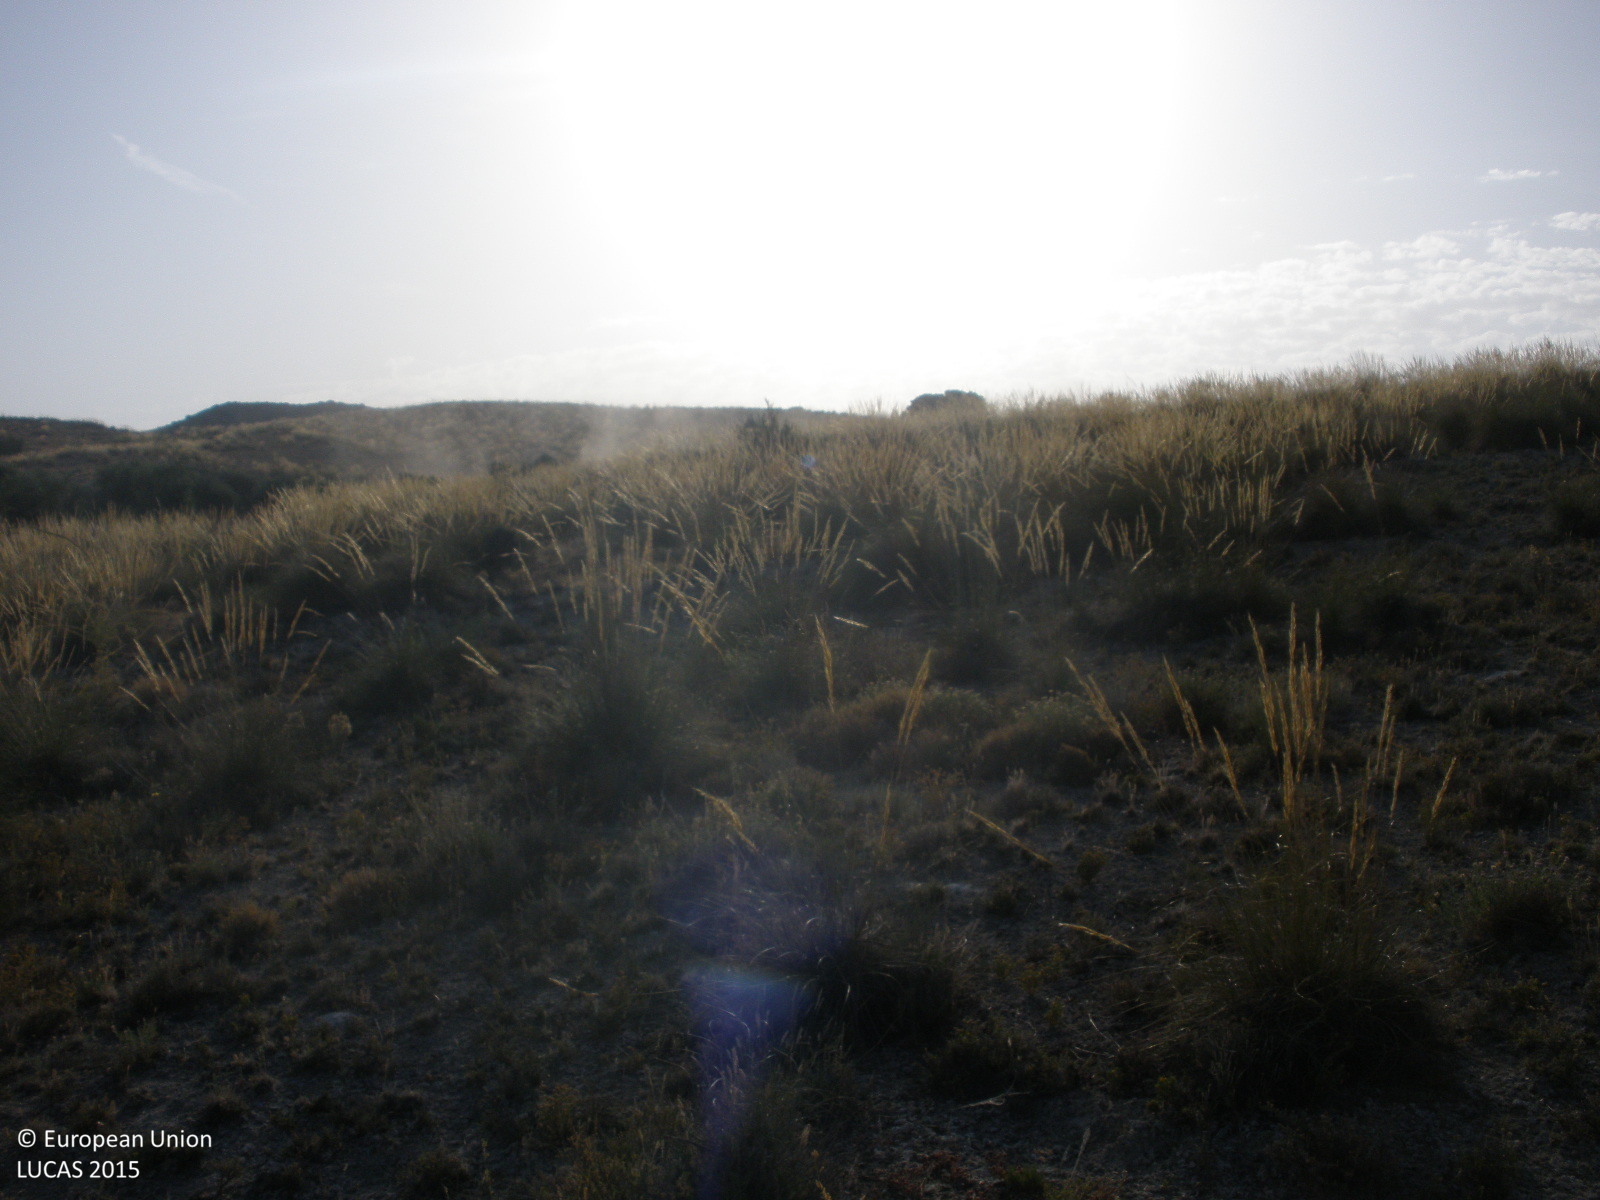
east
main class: Shrubland
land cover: Shrubland without tree cover
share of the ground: 25 - 50 %
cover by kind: shrubs 40 %, herbaceous plants 40 %, consolidated bare surface 20 %
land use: Semi-natural and natural areas not in use
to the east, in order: Shrubland without tree cover; Tracks; Shrubland without tree cover; Tracks; Shrubland without tree cover; Tracks; Shrubland without tree cover
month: July
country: ES
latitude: 40.0150
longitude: -3.4436
